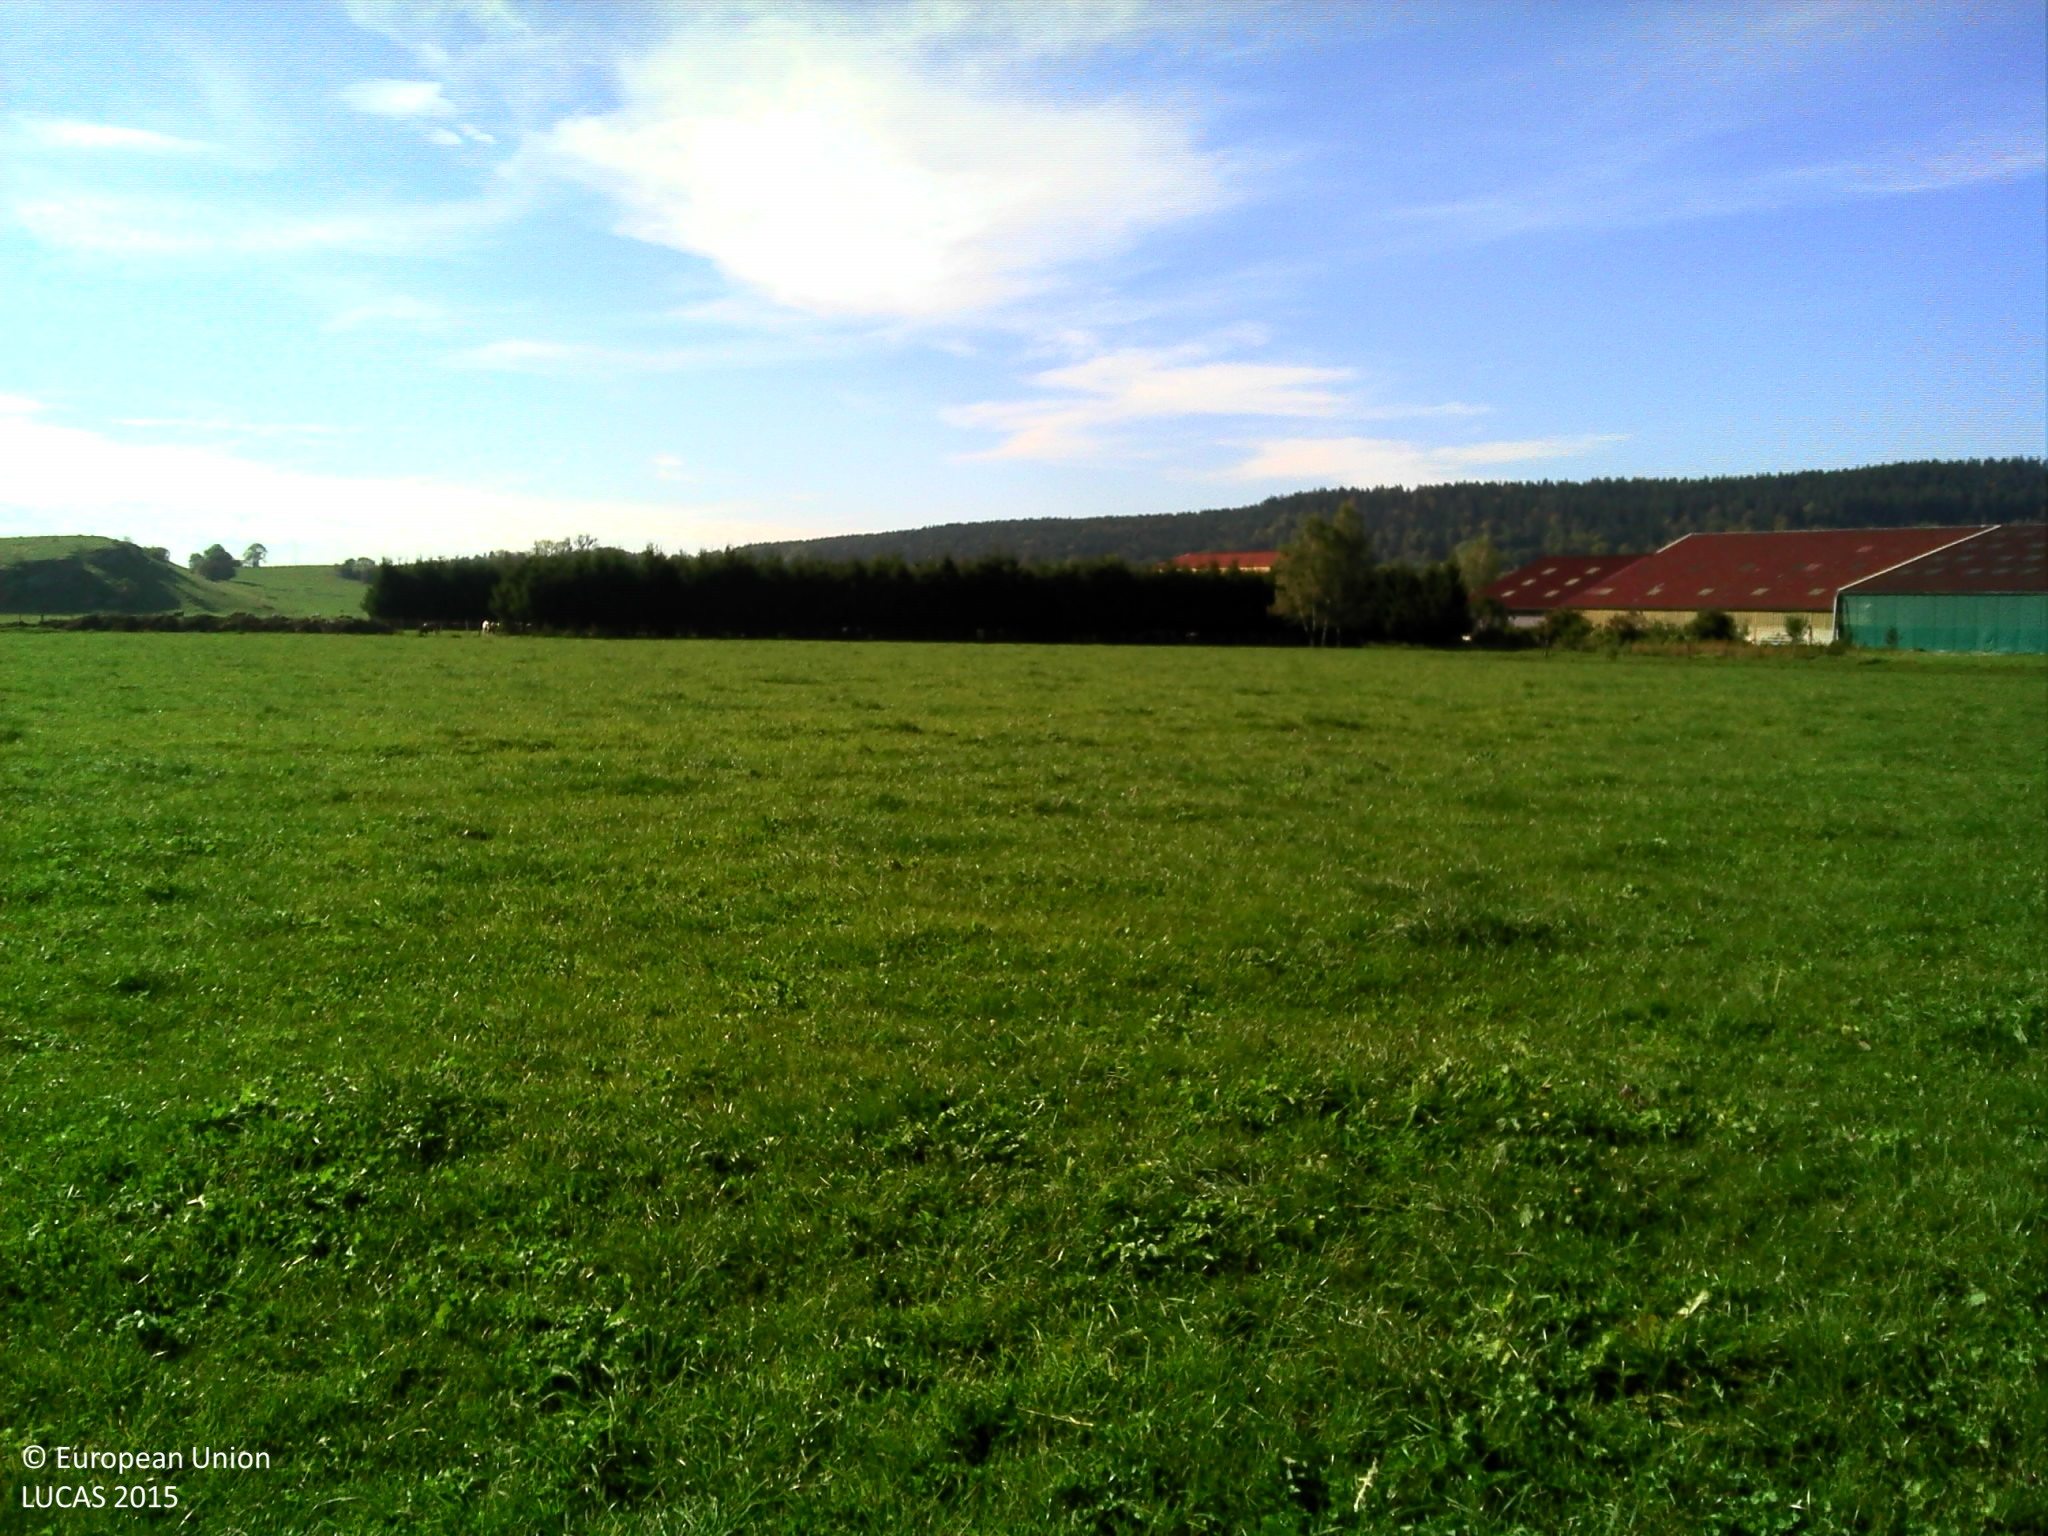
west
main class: Grassland
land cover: Grassland without tree/shrub cover
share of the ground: > 75 %
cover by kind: herbaceous plants 100 %
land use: Agriculture (excluding fallow land and kitchen gardens)
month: October
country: FR
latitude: 47.0471
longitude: 6.3825
